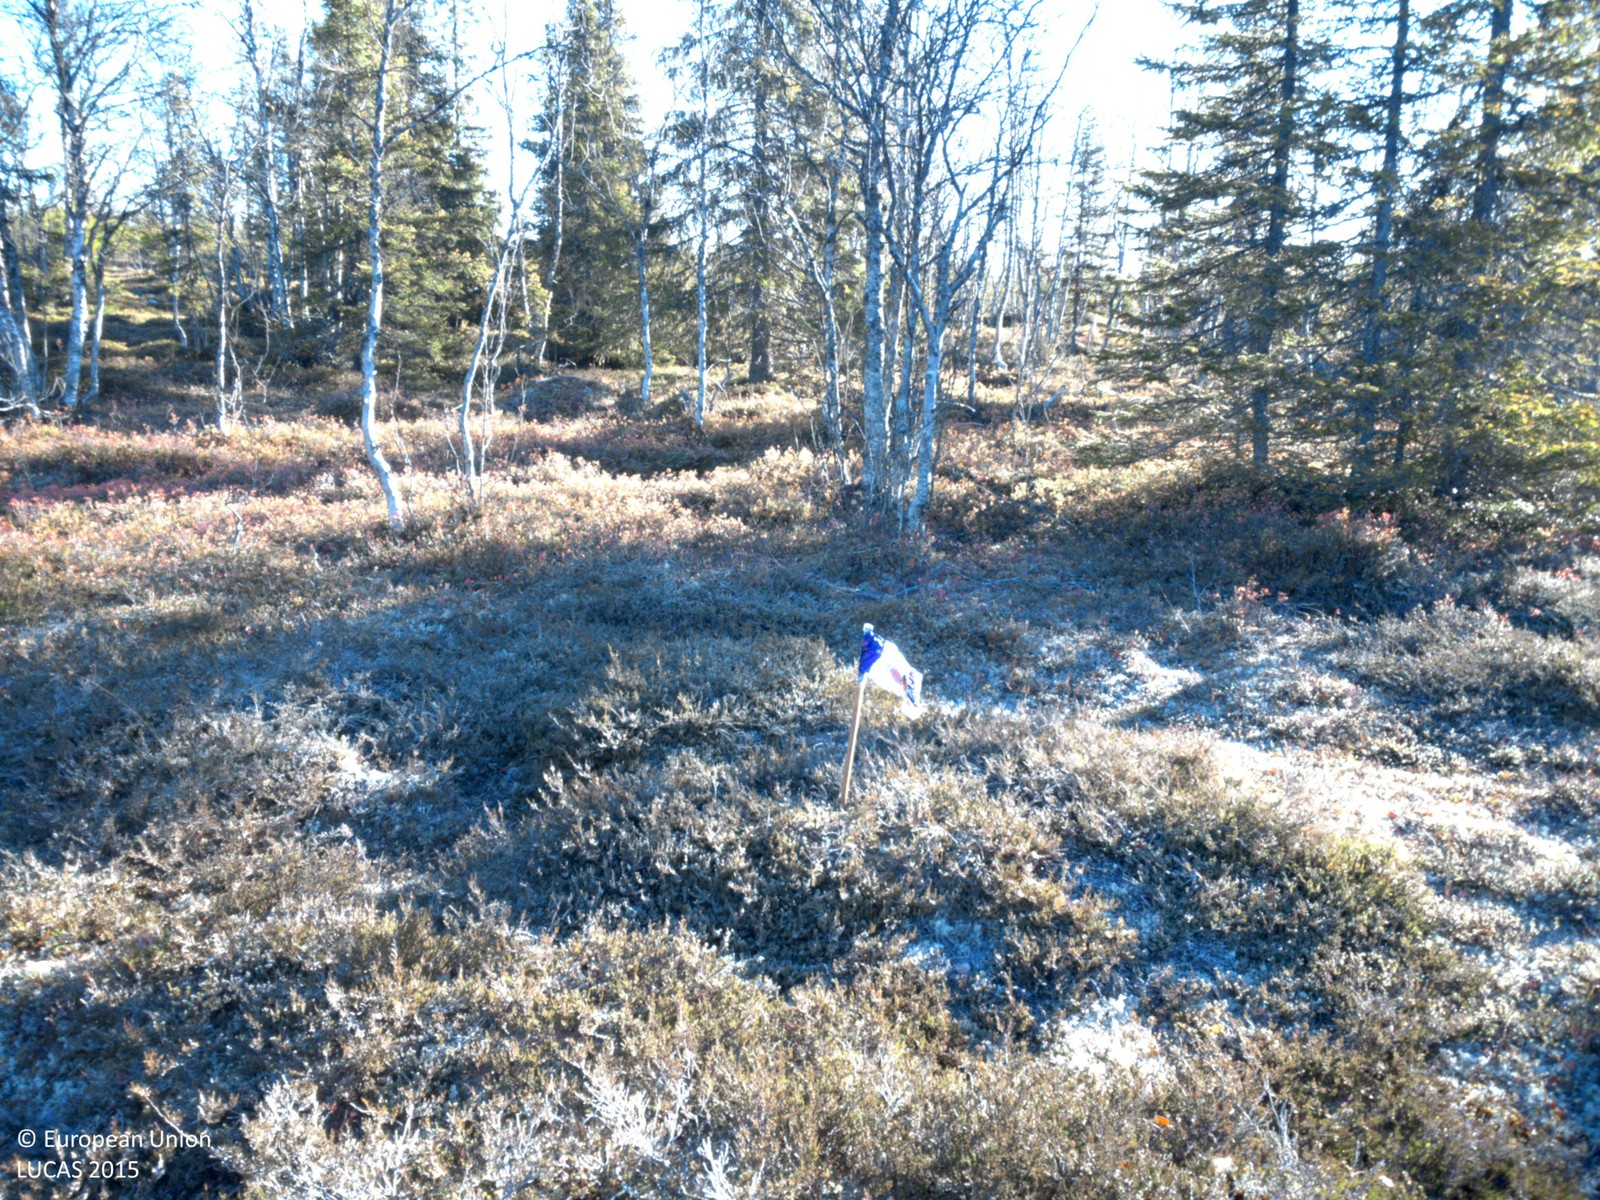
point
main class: Woodland
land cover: Spruce dominated mixed woodland
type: boreal forest
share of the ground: 25 - 50 %
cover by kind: shrubs 35 %, herbaceous plants 30 %, coniferous forest trees 15 %, broadleaved forest trees 15 %, lichens and mosses 5 %
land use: Forestry
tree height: < 5 m
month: October
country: SE
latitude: 64.5917
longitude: 17.7162
